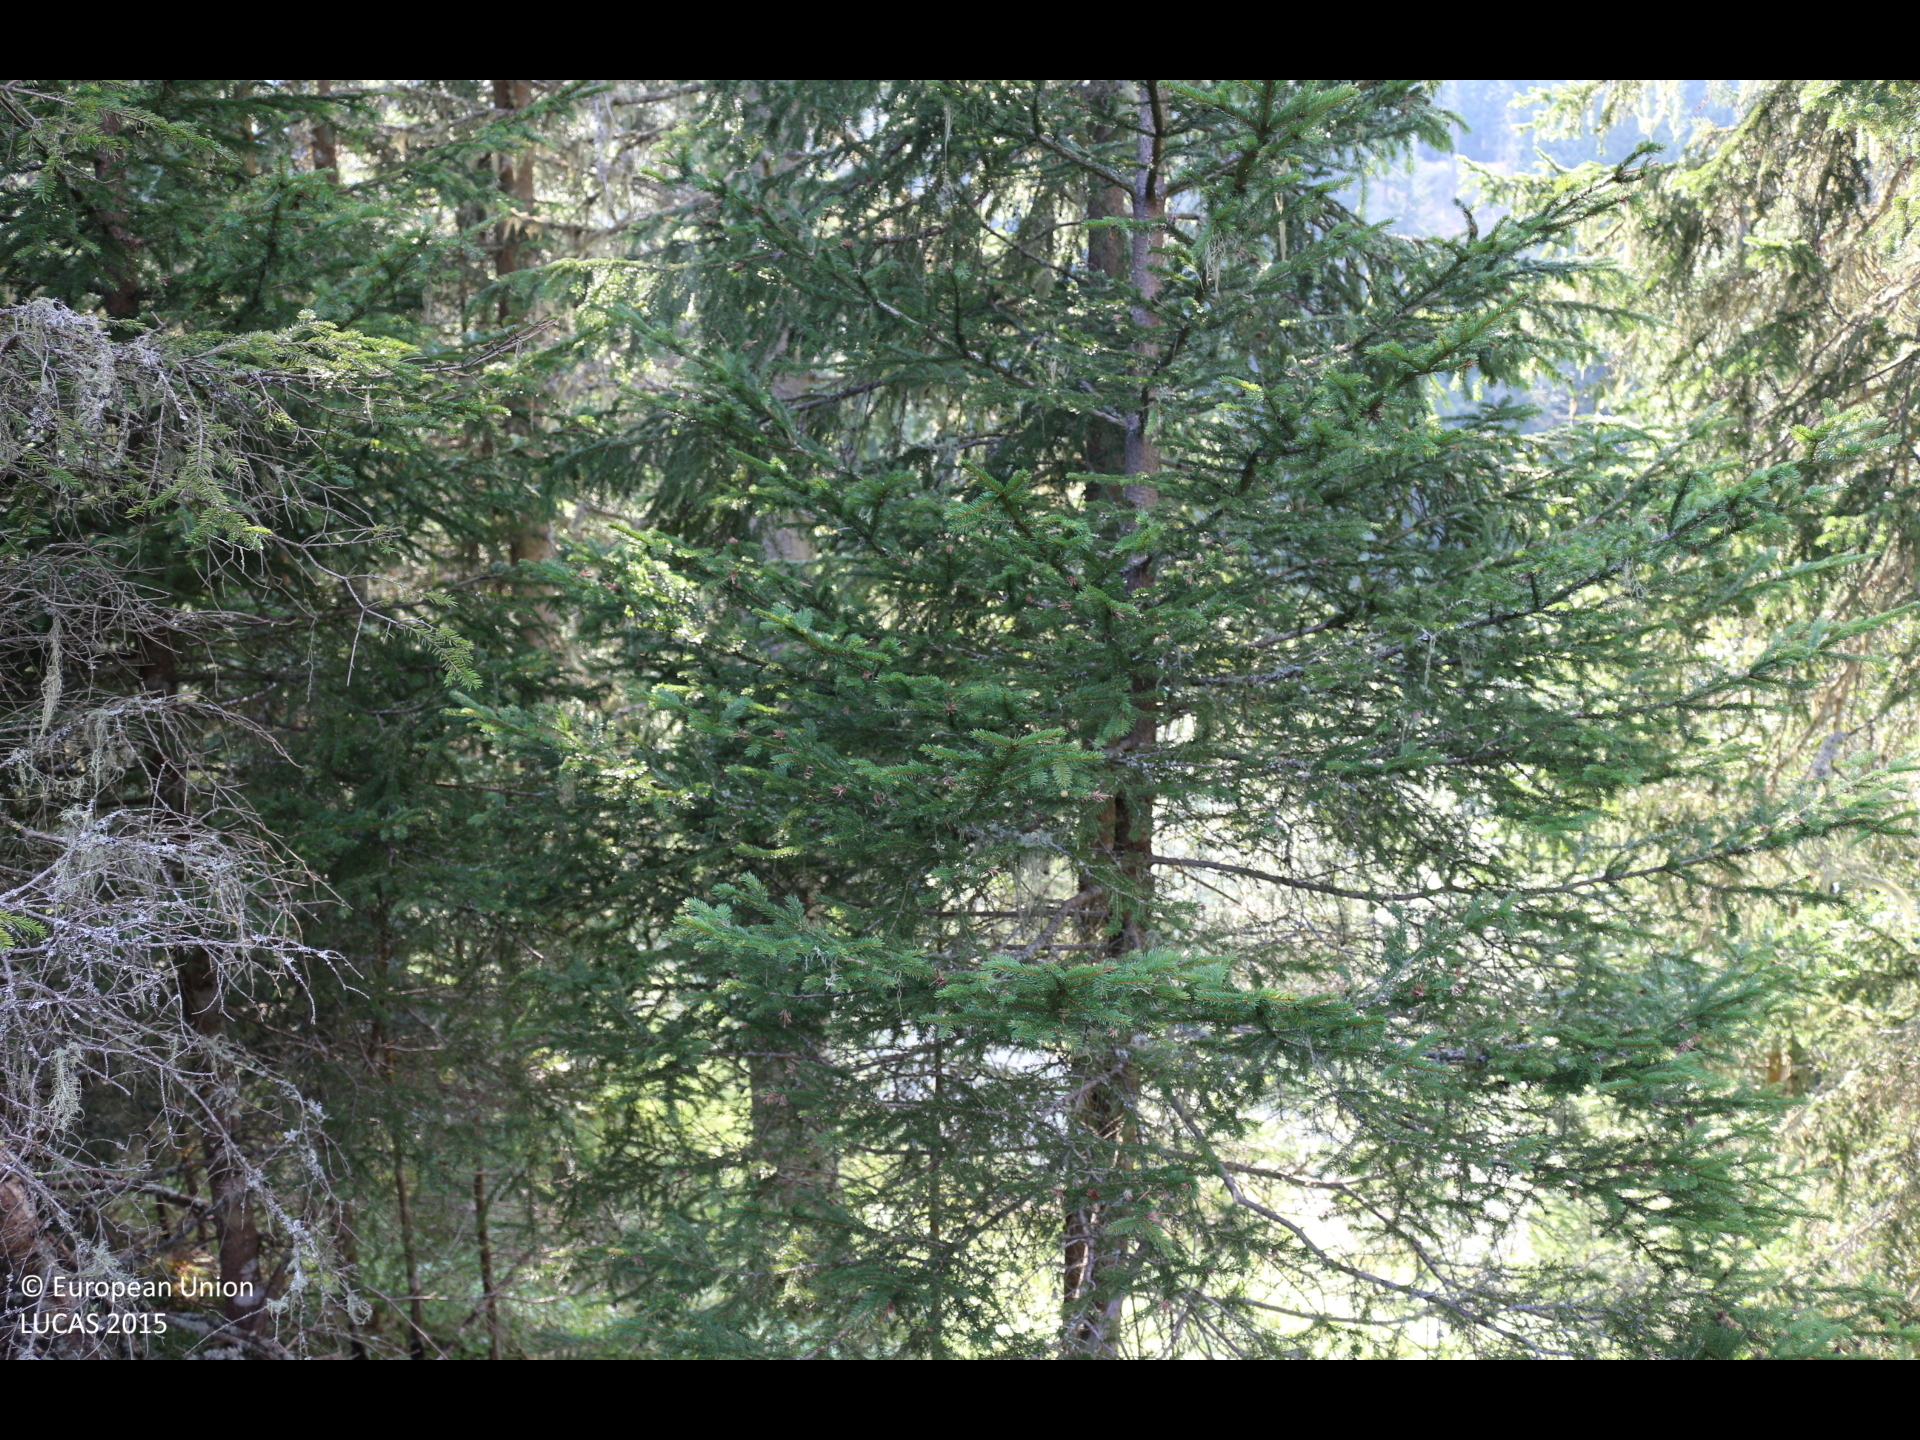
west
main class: Woodland
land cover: Spruce dominated coniferous woodland
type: alpine coniferous forest
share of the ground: > 75 %
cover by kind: coniferous forest trees 90 %, shrubs 5 %, lichens and mosses 5 %
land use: Forestry
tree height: > 5 m
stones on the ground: 10 - 25 %
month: August
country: AT
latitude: 46.9793
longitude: 14.0074
